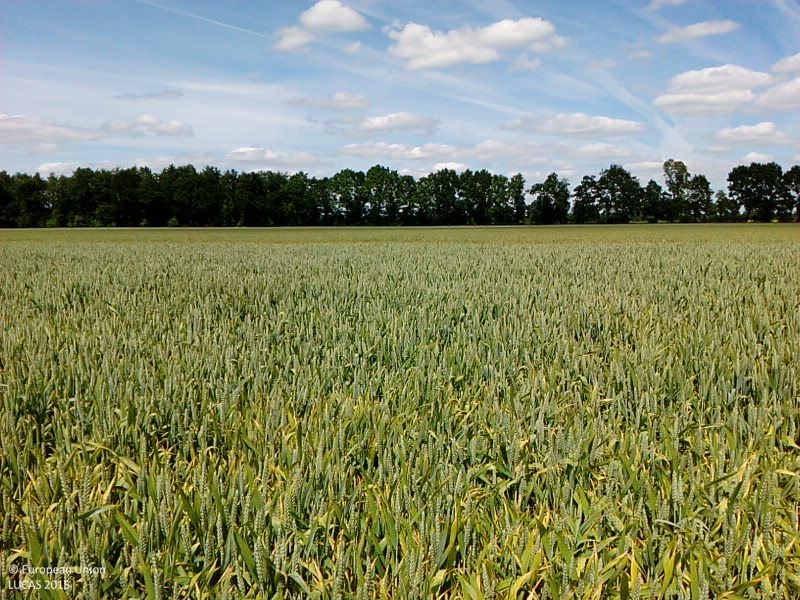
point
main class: Cropland
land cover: Common wheat
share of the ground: > 75 %
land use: Agriculture (excluding fallow land and kitchen gardens)
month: June
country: DE
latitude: 52.5473
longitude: 7.4197
